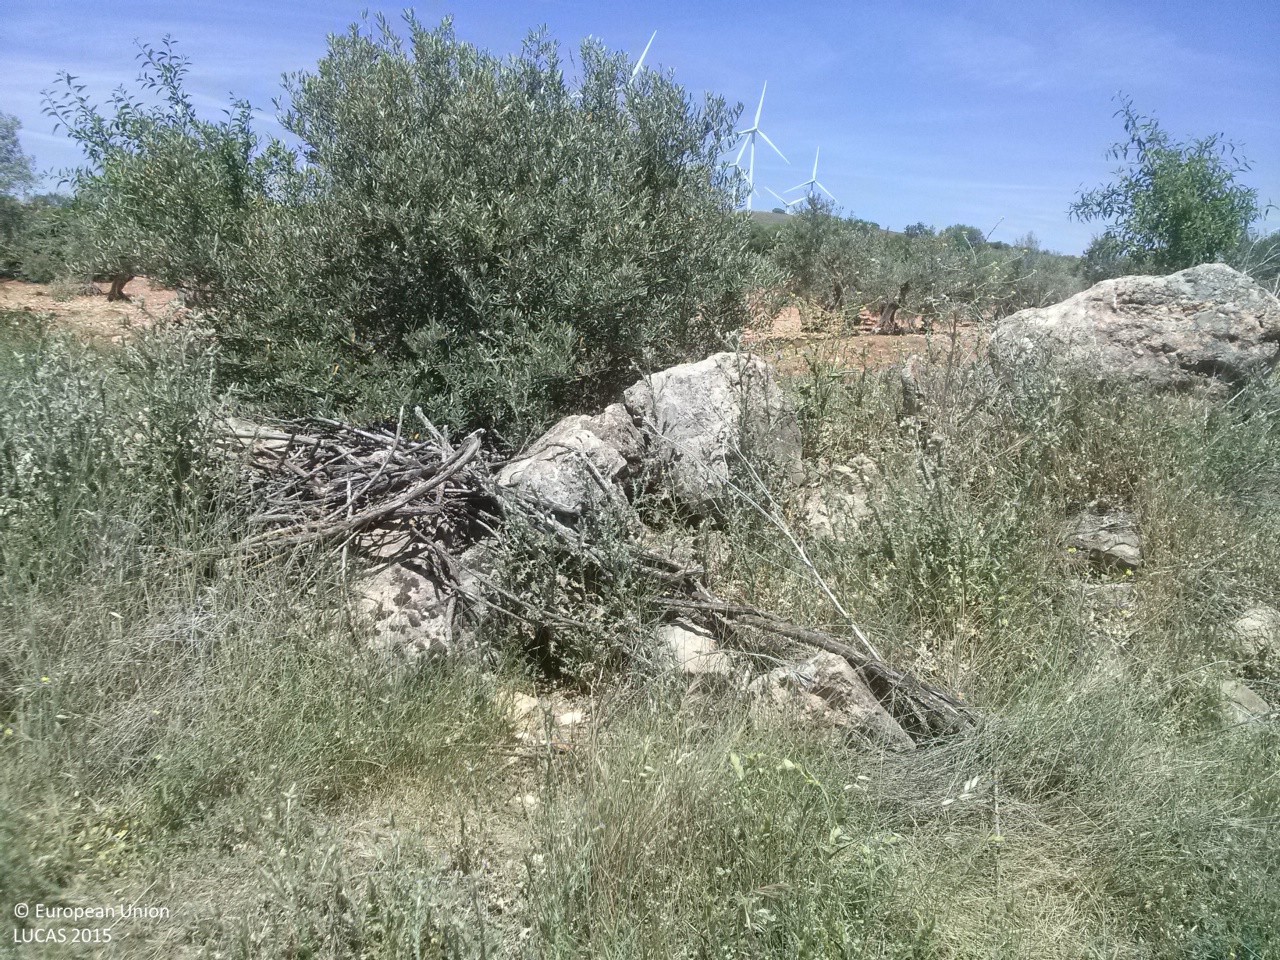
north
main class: Cropland
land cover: Sunflower
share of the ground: < 10 %
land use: Agriculture (excluding fallow land and kitchen gardens)
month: May
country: ES
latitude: 39.9806
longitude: -2.7494
